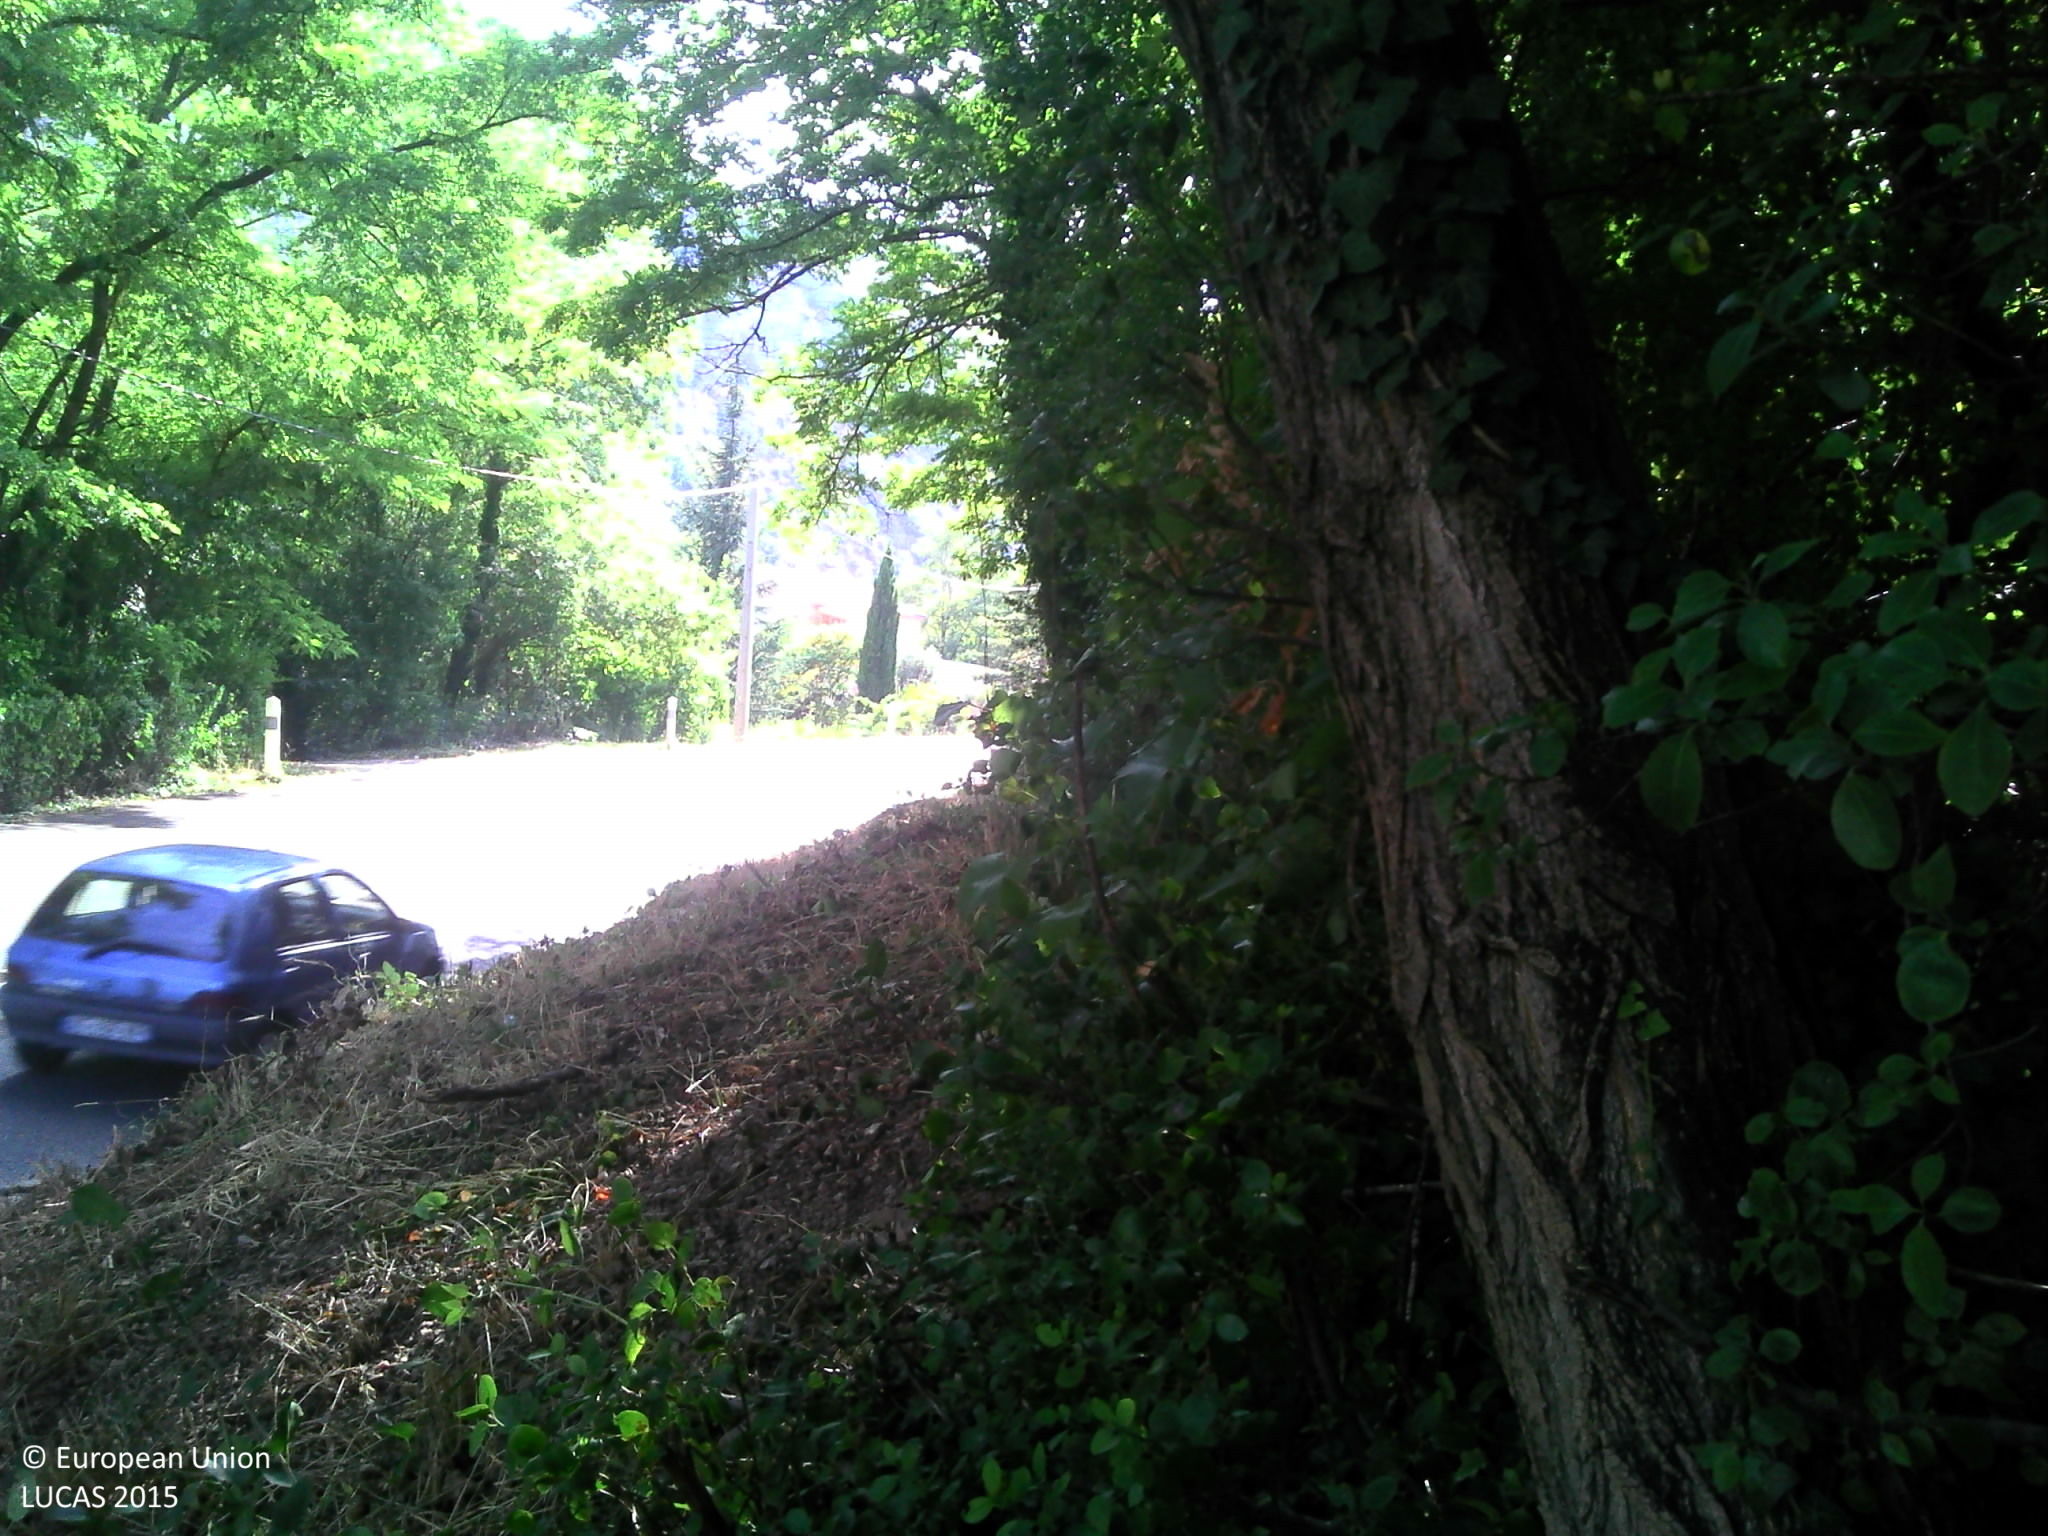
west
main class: Woodland
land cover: Broadleaved woodland
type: coniferous forest of the mediterranean region
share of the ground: > 75 %
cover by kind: broadleaved forest trees 50 %, shrubs 10 %
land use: Semi-natural and natural areas not in use
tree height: > 5 m
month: July
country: FR
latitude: 44.7591
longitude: 4.7381
